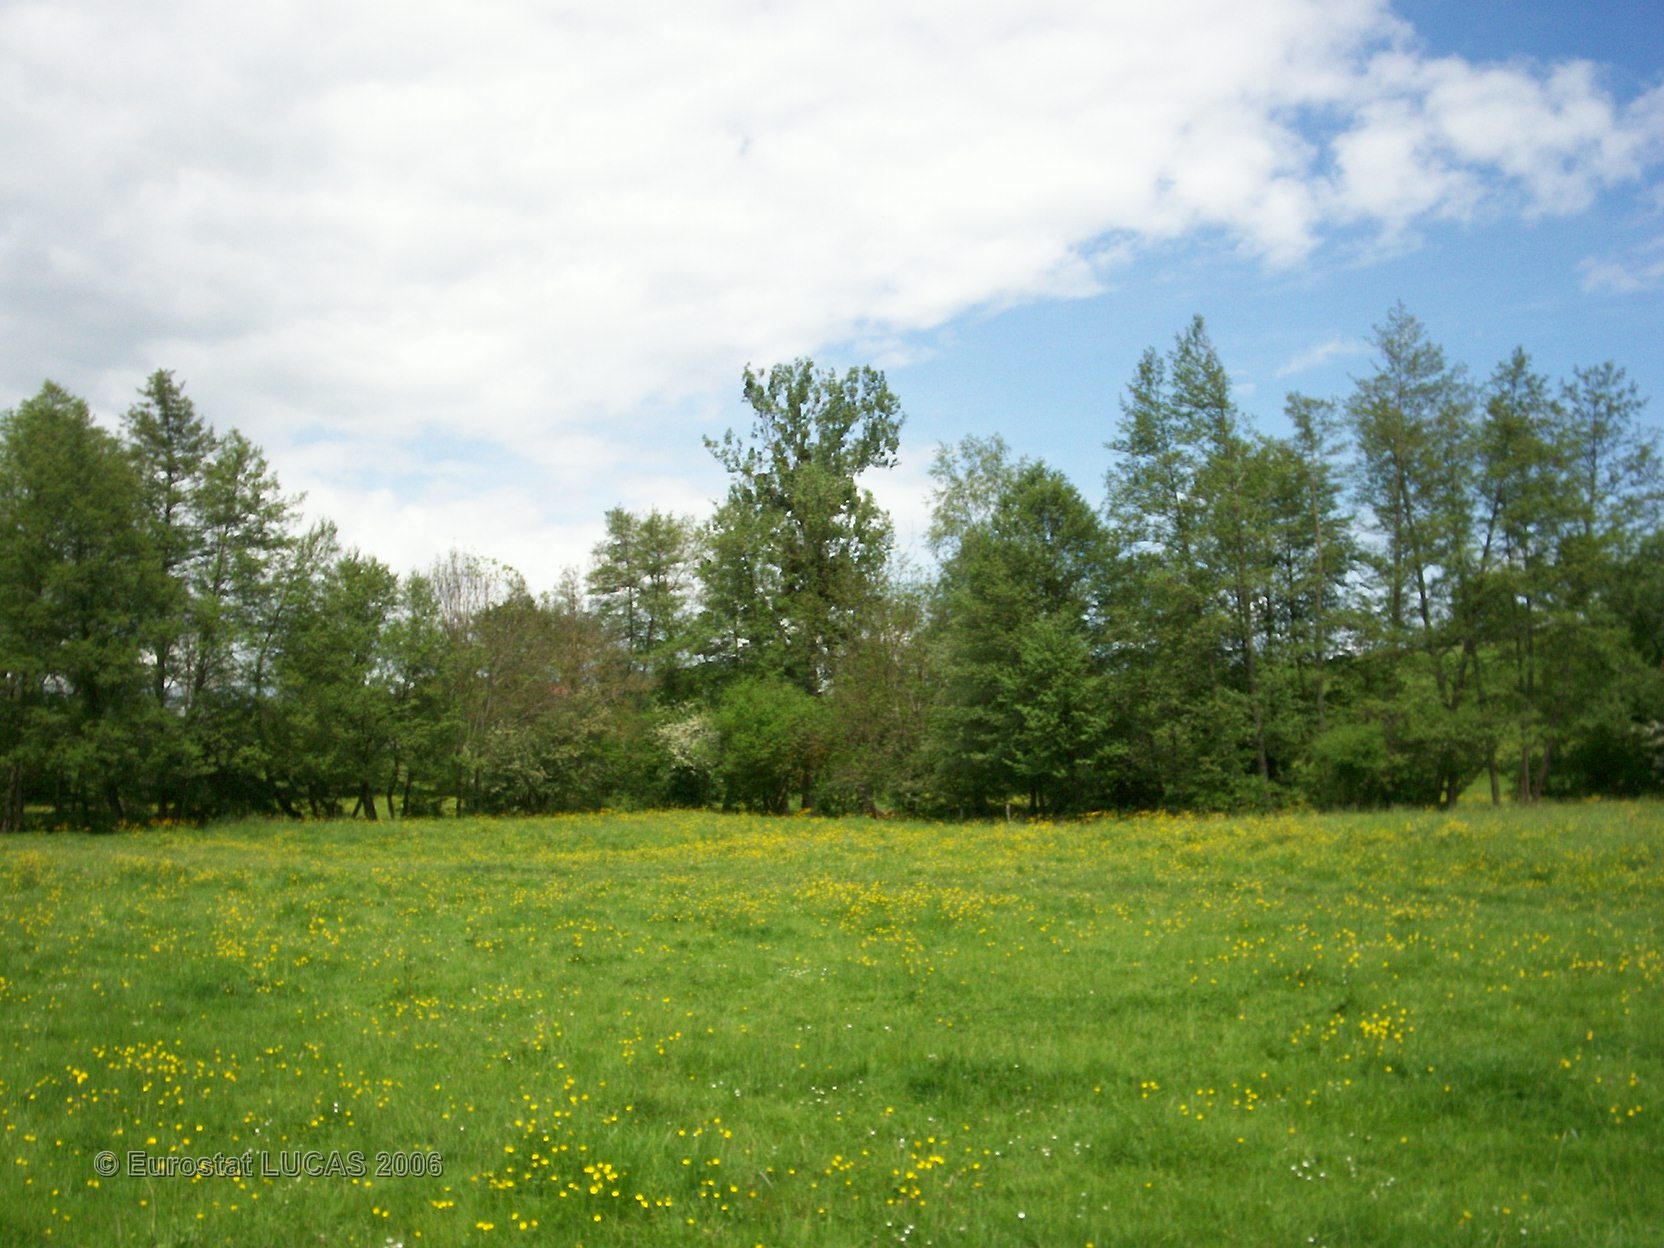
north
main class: Grassland
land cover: Grassland without tree/shrub cover
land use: Agriculture (excluding fallow land and kitchen gardens)
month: May
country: FR
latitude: 46.1183
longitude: 4.1397
